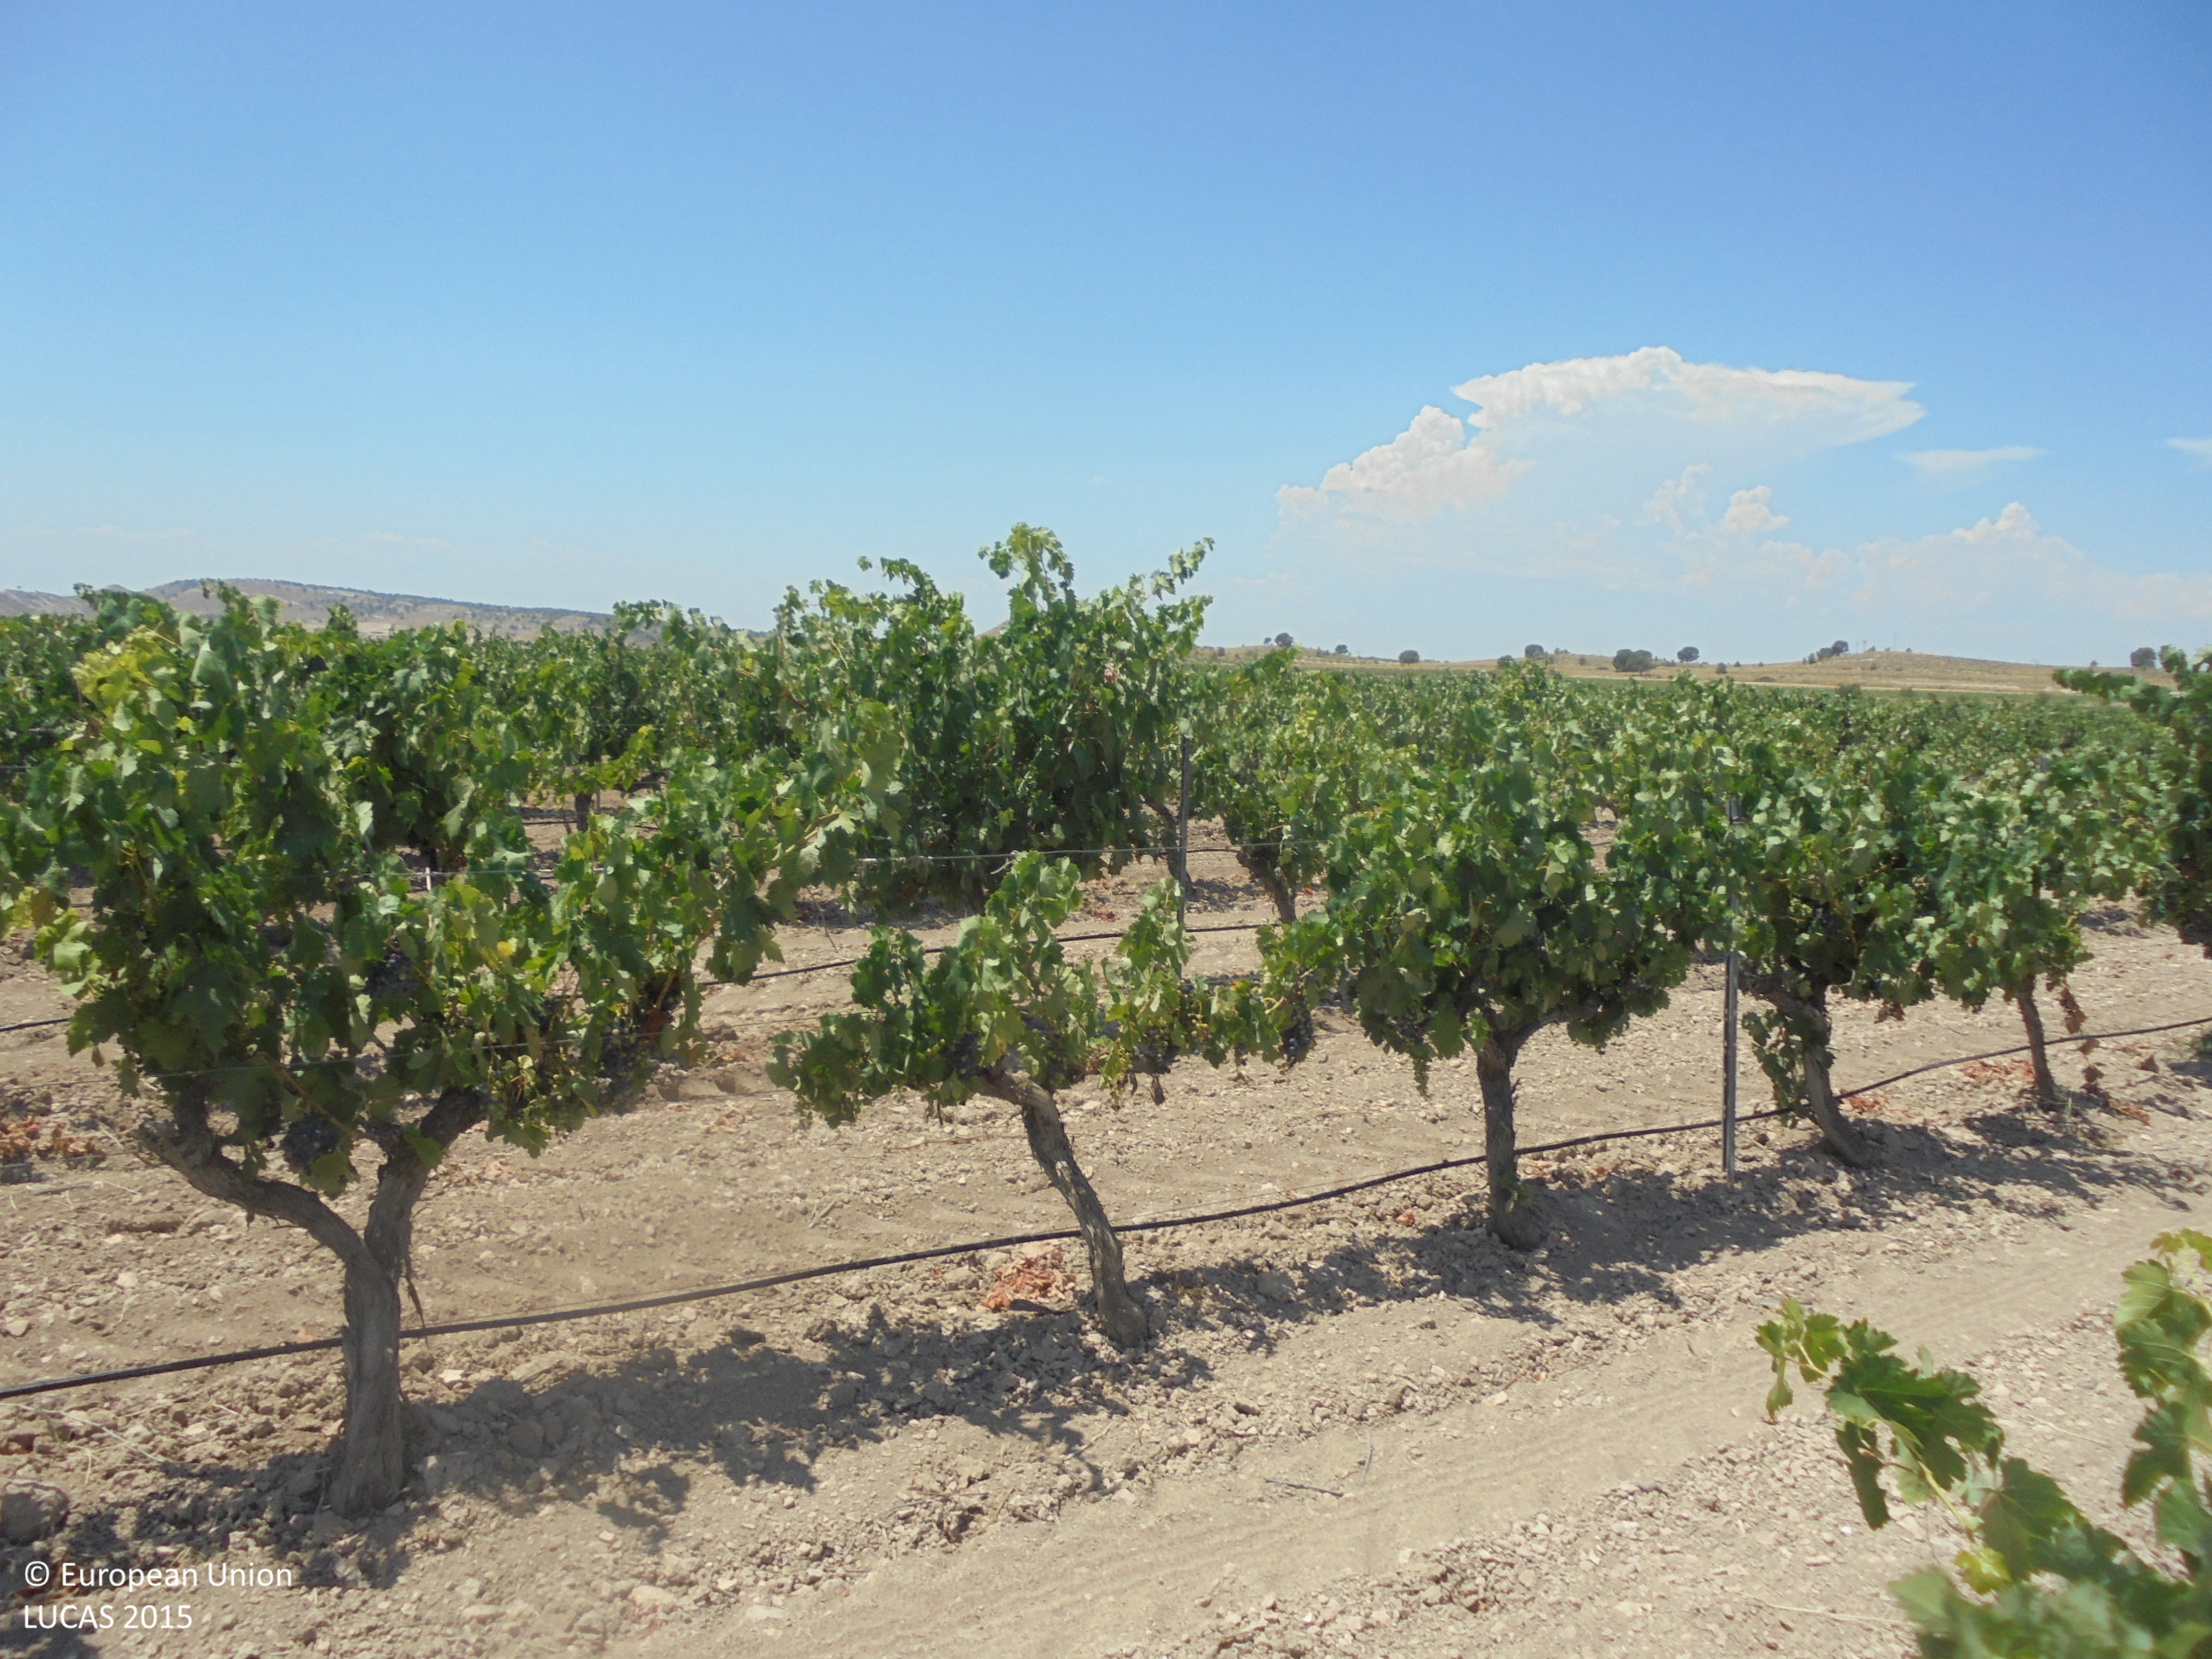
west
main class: Cropland
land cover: Vineyards
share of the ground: 10 - 25 %
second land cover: Other bare soil
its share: > 75 %
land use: Agriculture (excluding fallow land and kitchen gardens)
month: July
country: ES
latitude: 38.5635
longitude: -1.3652
